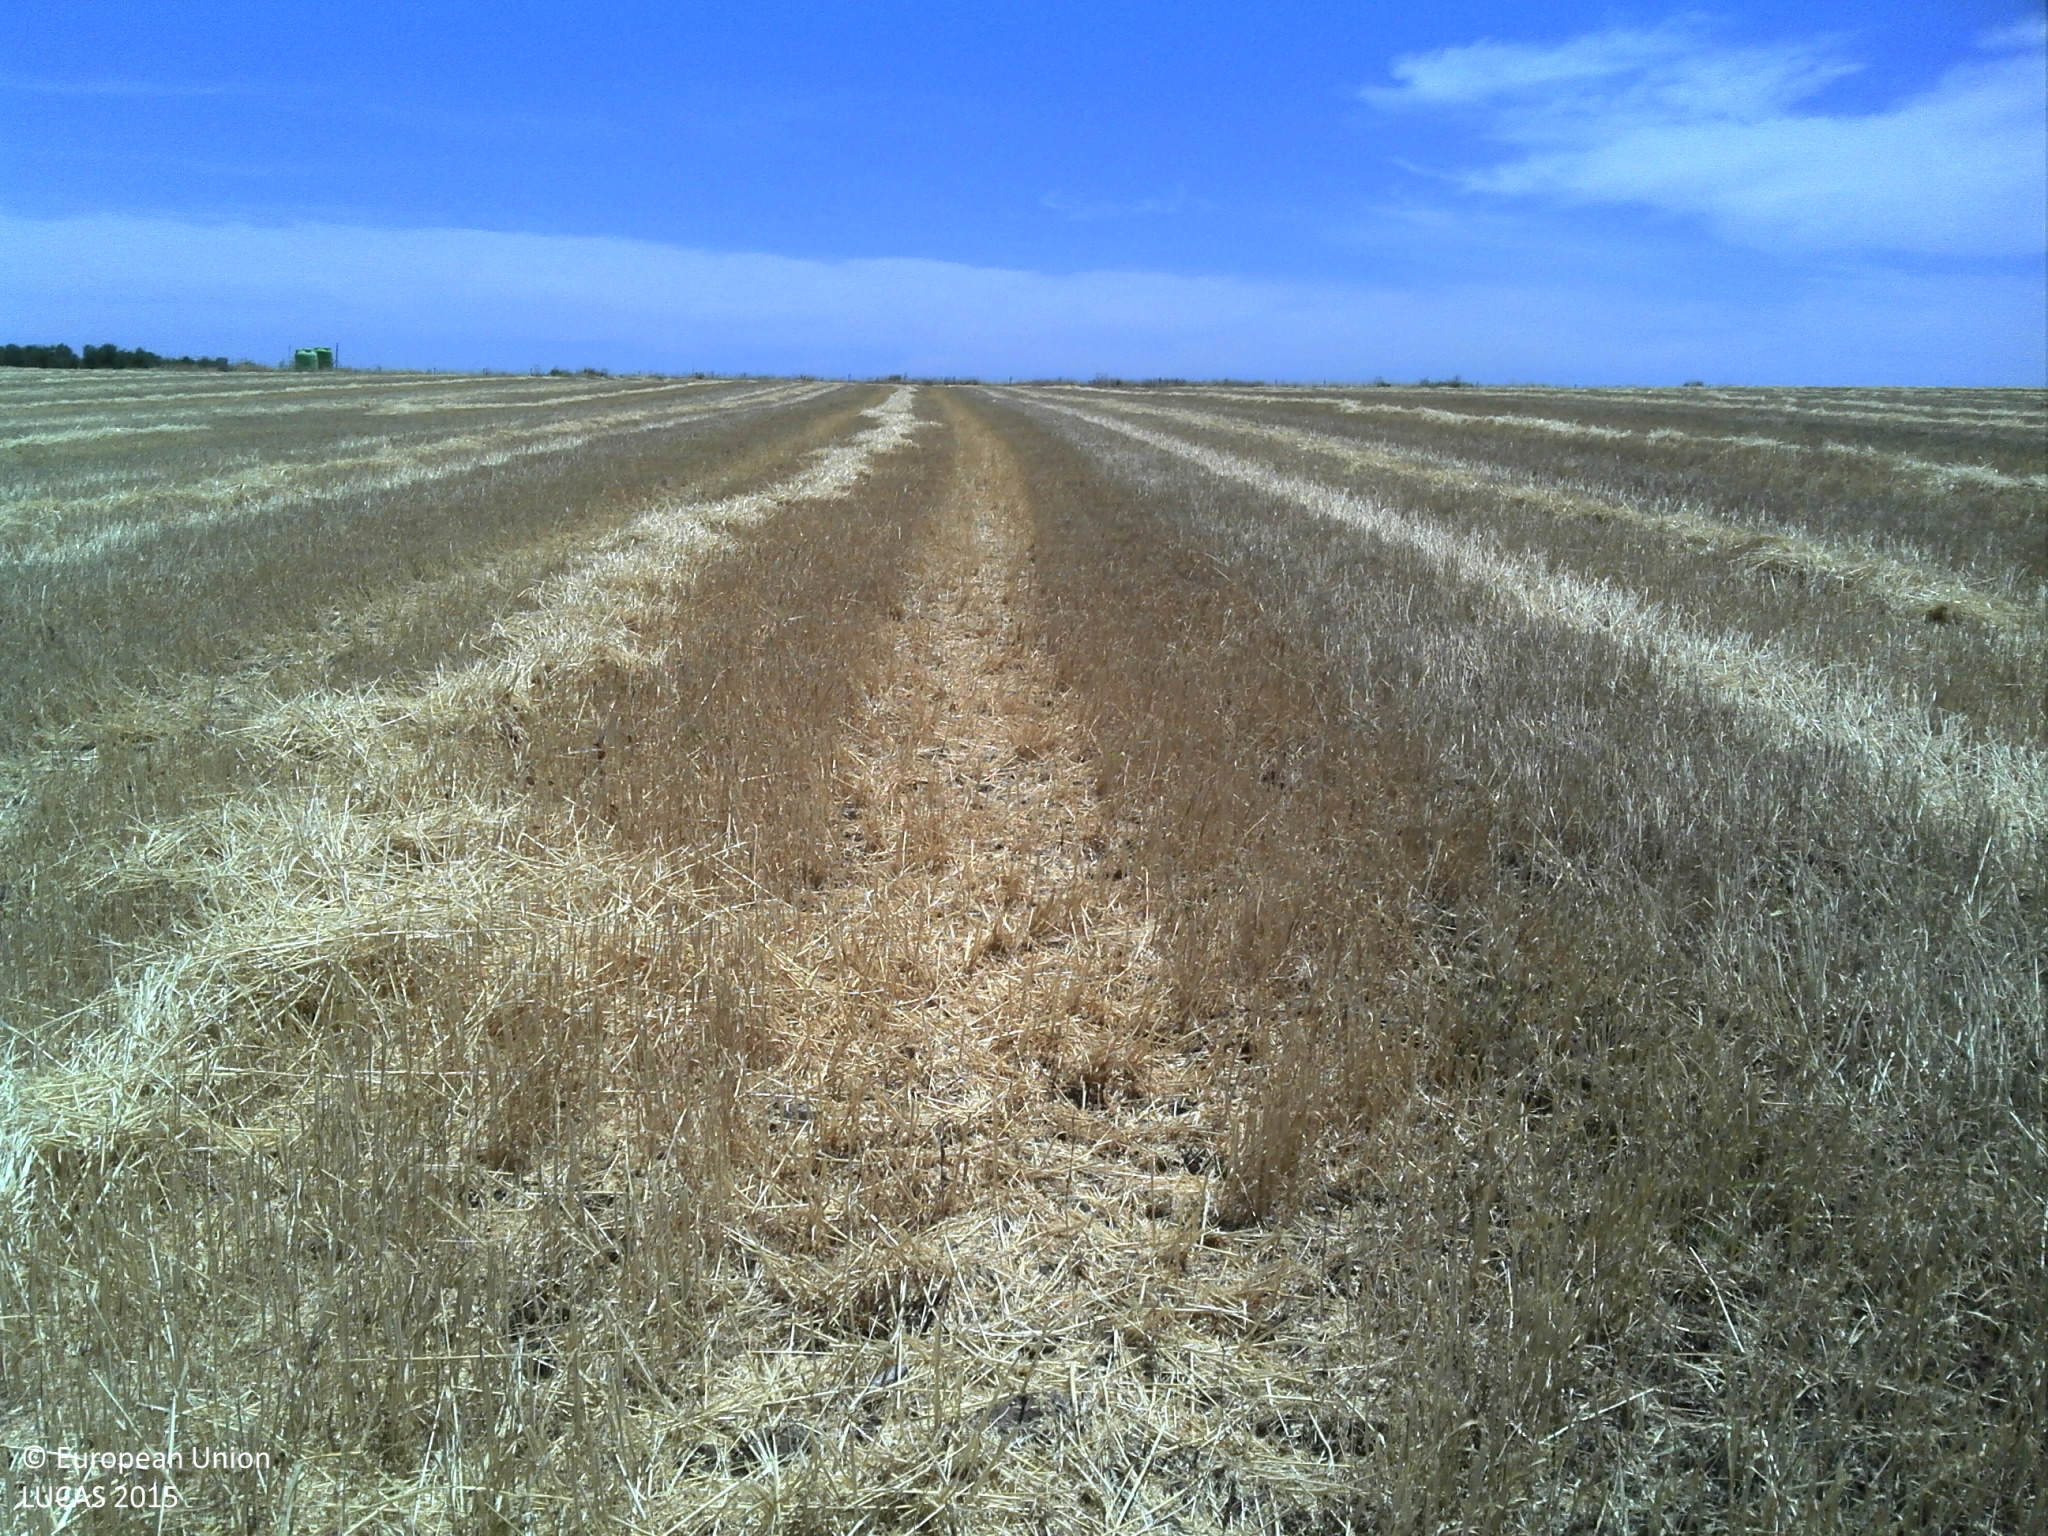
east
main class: Cropland
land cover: Common wheat
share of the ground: > 75 %
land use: Agriculture (excluding fallow land and kitchen gardens)
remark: Harvested field
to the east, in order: Common wheat; Ditches and canals; Grass margins; Tracks; Ditches and canals; Grass margins; Fences; Grass margins; Tracks; Other fresh vegetables
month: June
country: PT
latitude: 37.9362
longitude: -7.5294
